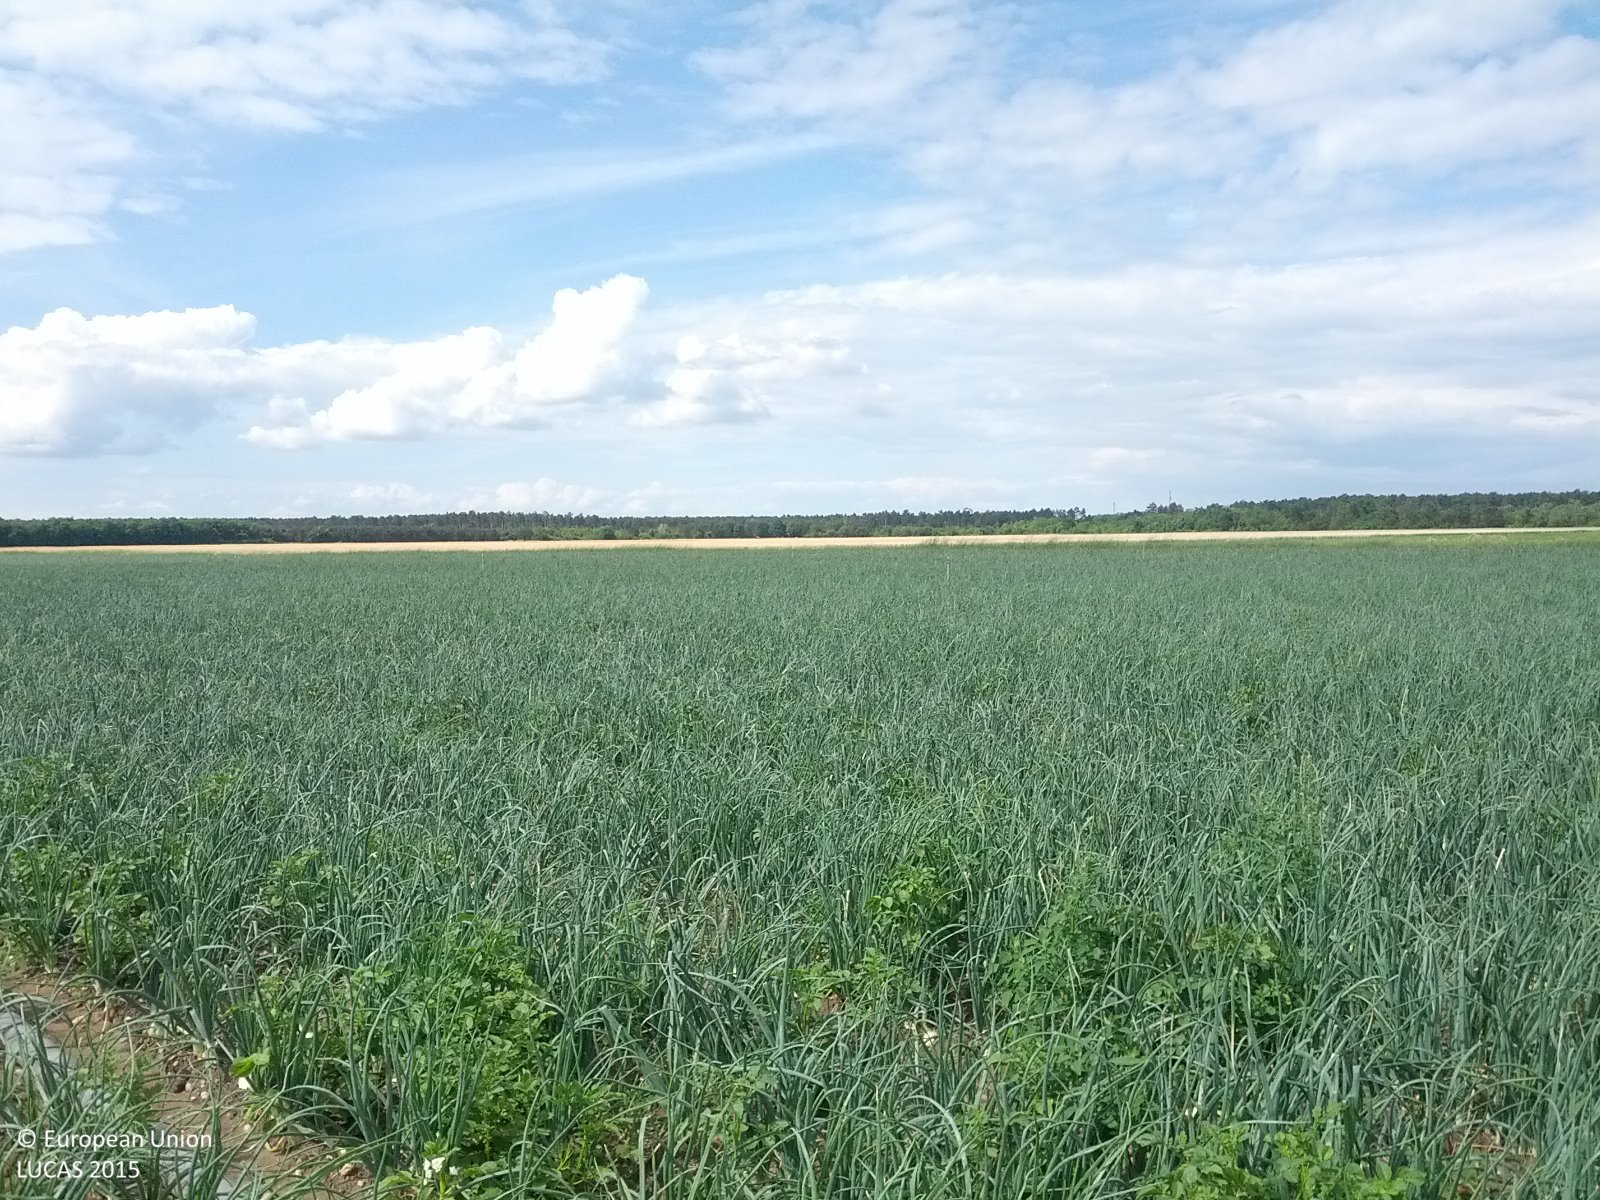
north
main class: Cropland
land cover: Other root crops
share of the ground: > 75 %
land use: Agriculture (excluding fallow land and kitchen gardens)
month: June
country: AT
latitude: 48.2902
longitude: 16.7051
